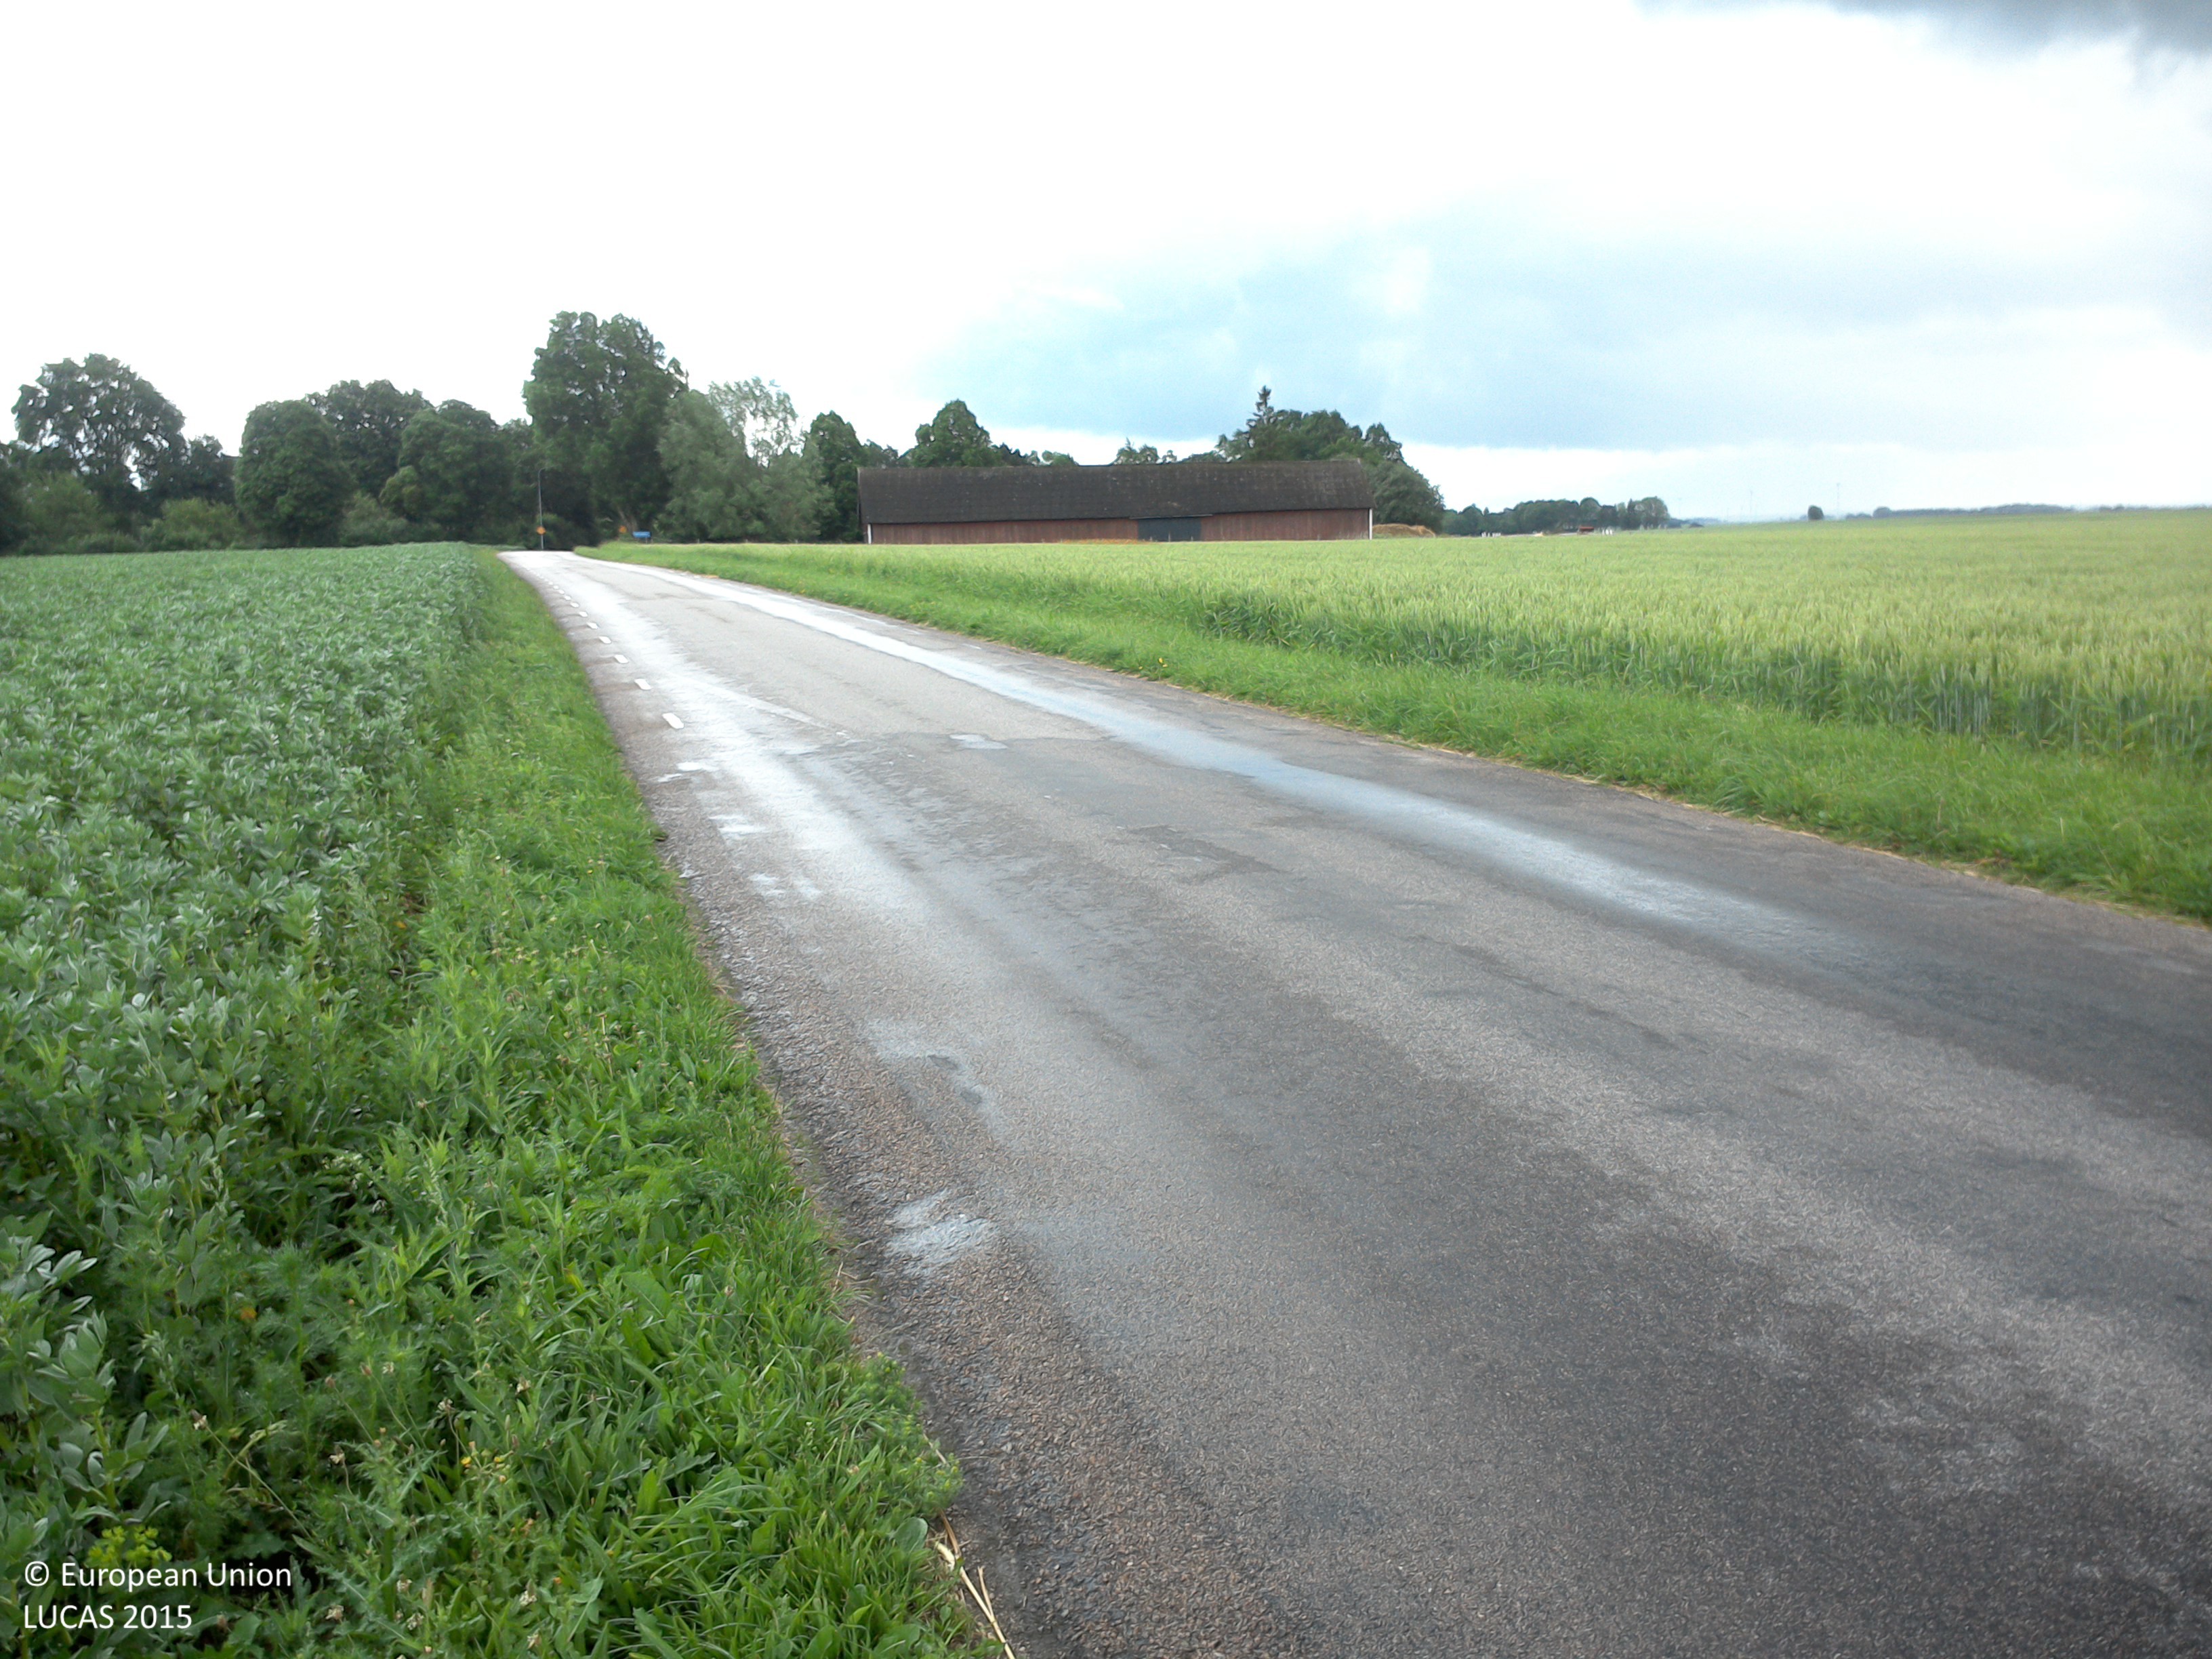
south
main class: Cropland
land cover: Dry pulses
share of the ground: > 75 %
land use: Agriculture (excluding fallow land and kitchen gardens)
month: July
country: SE
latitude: 58.4159
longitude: 14.9753
